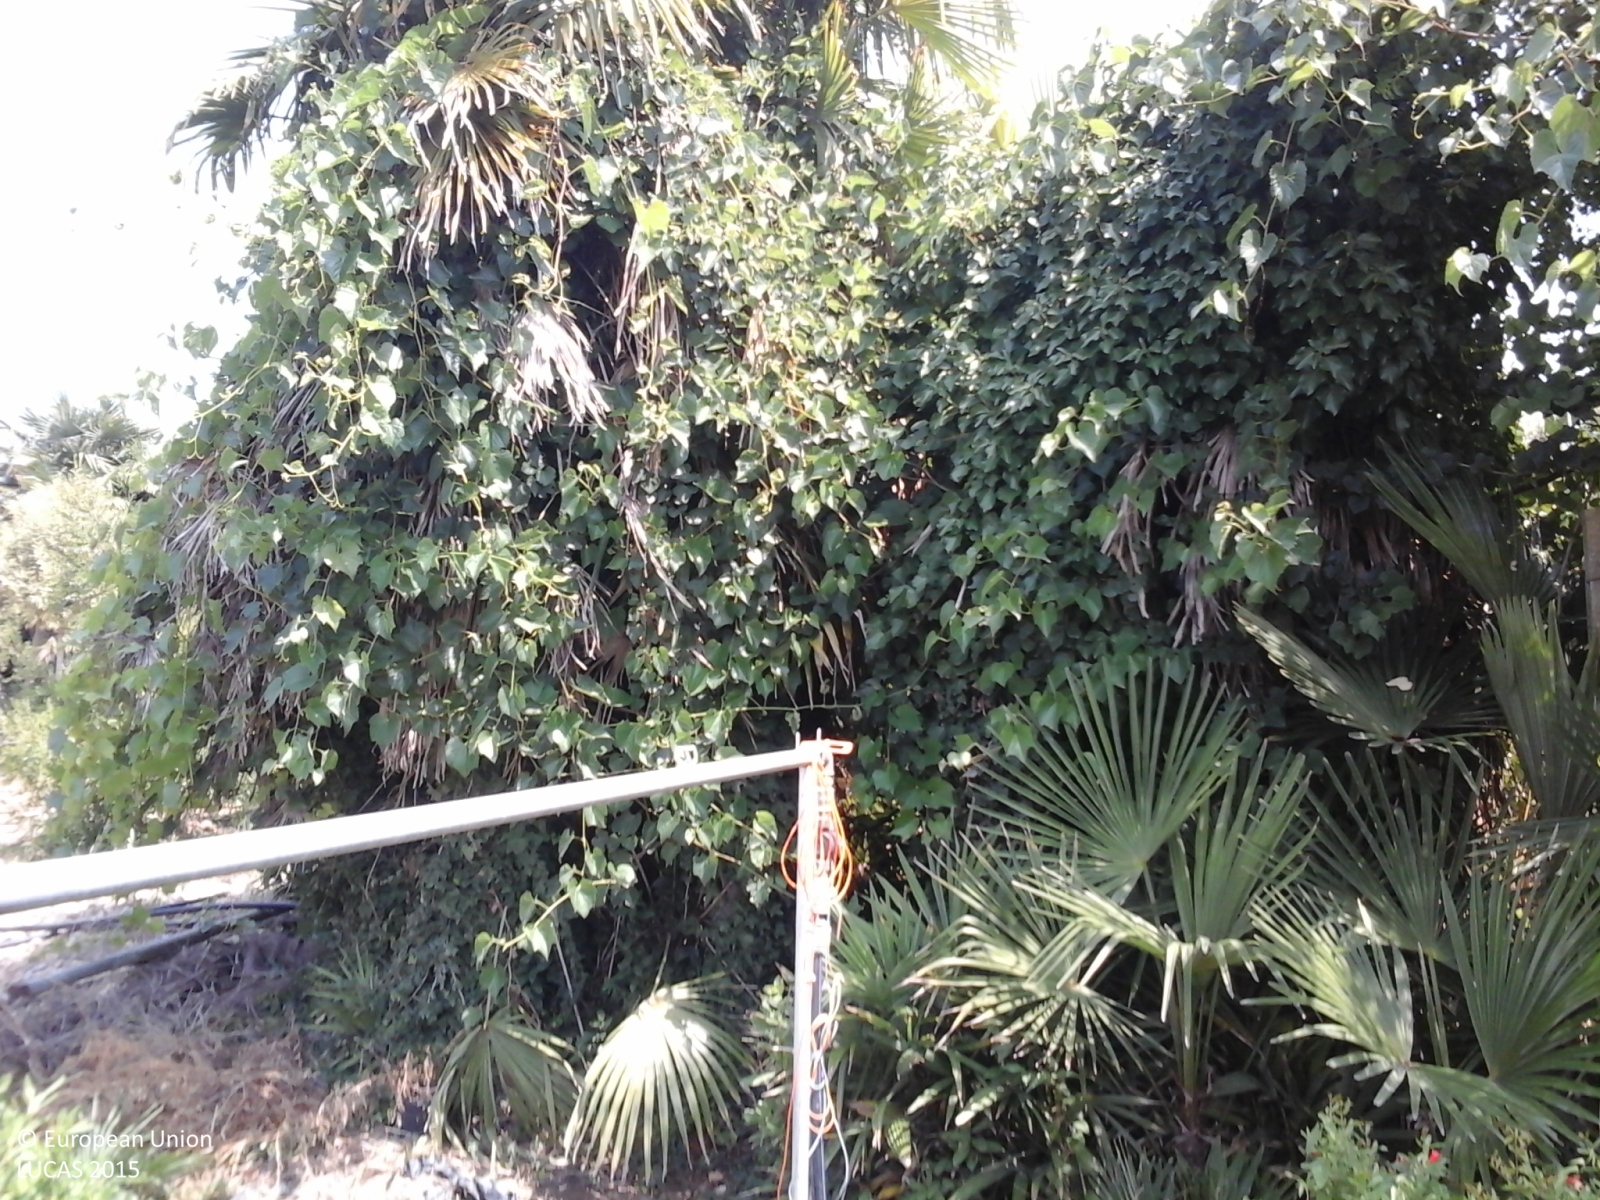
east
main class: Cropland
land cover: Nurseries
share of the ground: > 75 %
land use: Agriculture (excluding fallow land and kitchen gardens)
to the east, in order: Nurseries; Artificial constructions in urban areas; Nurseries; Electric lines; Nurseries; Barley; Nurseries; Paved roads, cycling and walking lanes; Electric lines; Grass margins
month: July
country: IT
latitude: 43.0344
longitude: 13.8070
